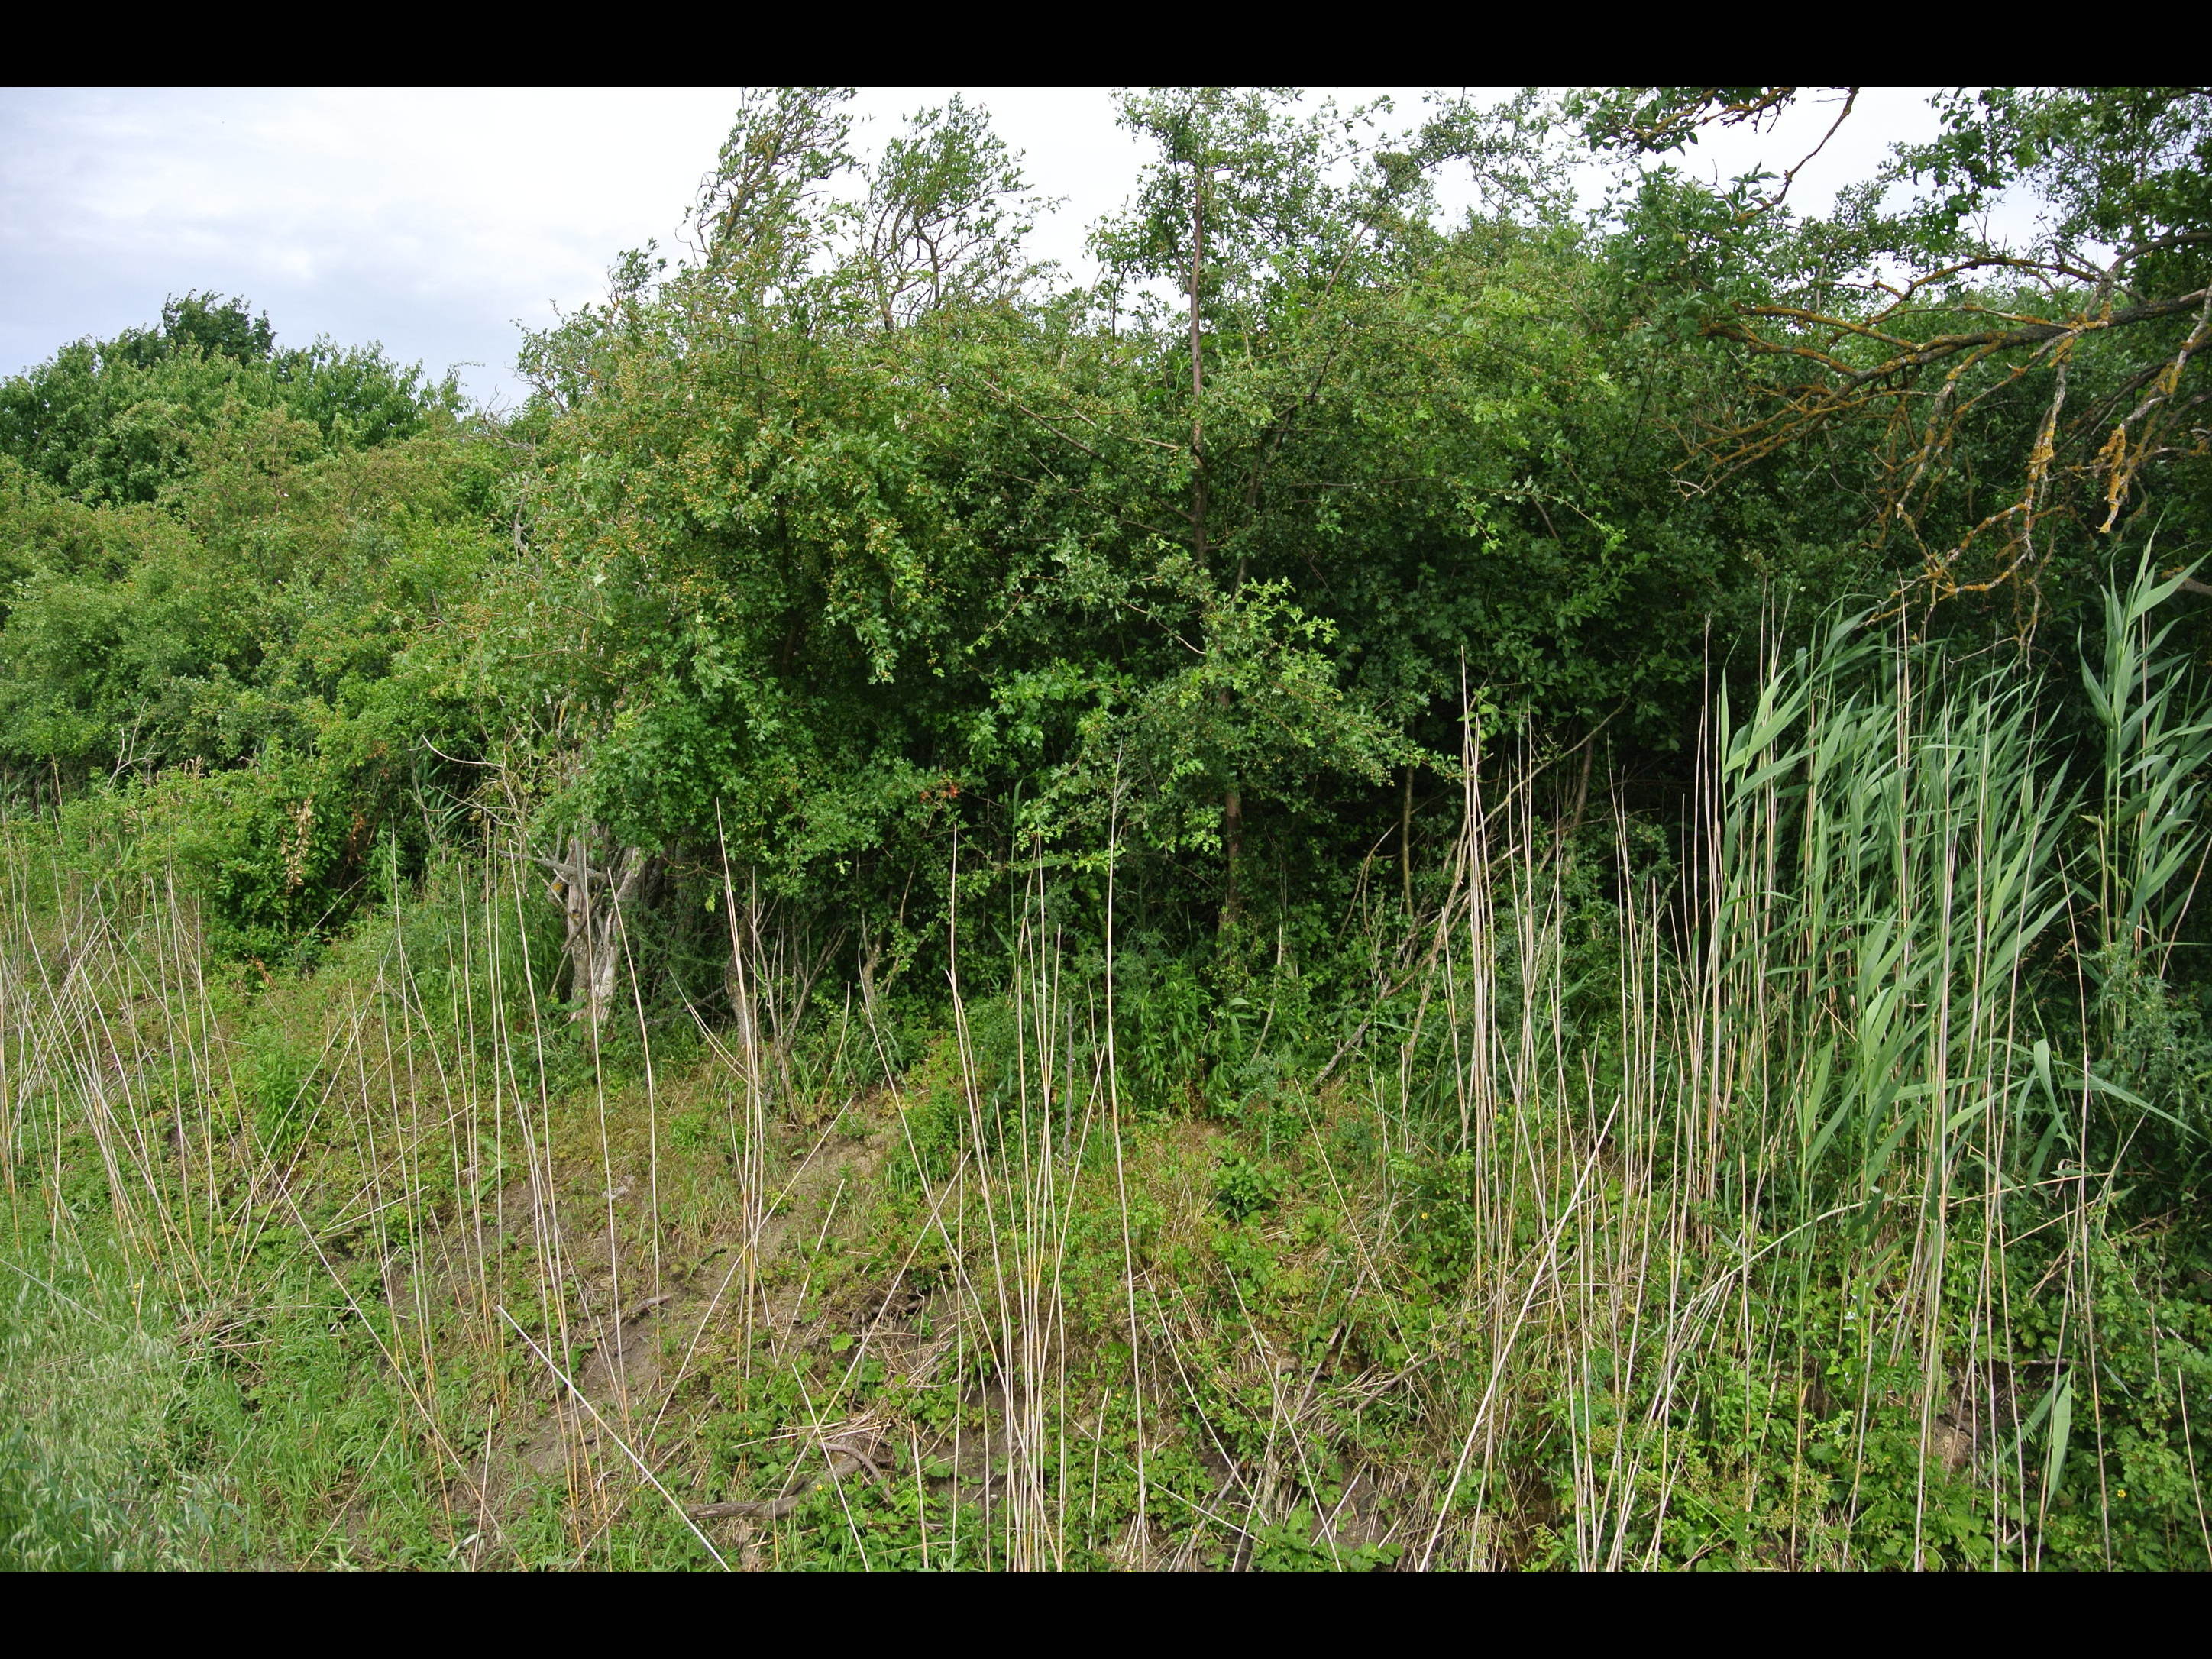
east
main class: Cropland
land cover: Common wheat
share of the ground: > 75 %
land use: Agriculture (excluding fallow land and kitchen gardens)
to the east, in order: Common wheat; Grass margins; Ditches and canals; Shrubland with sparse tree cover
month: June
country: AT
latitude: 47.7218
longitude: 16.5502
